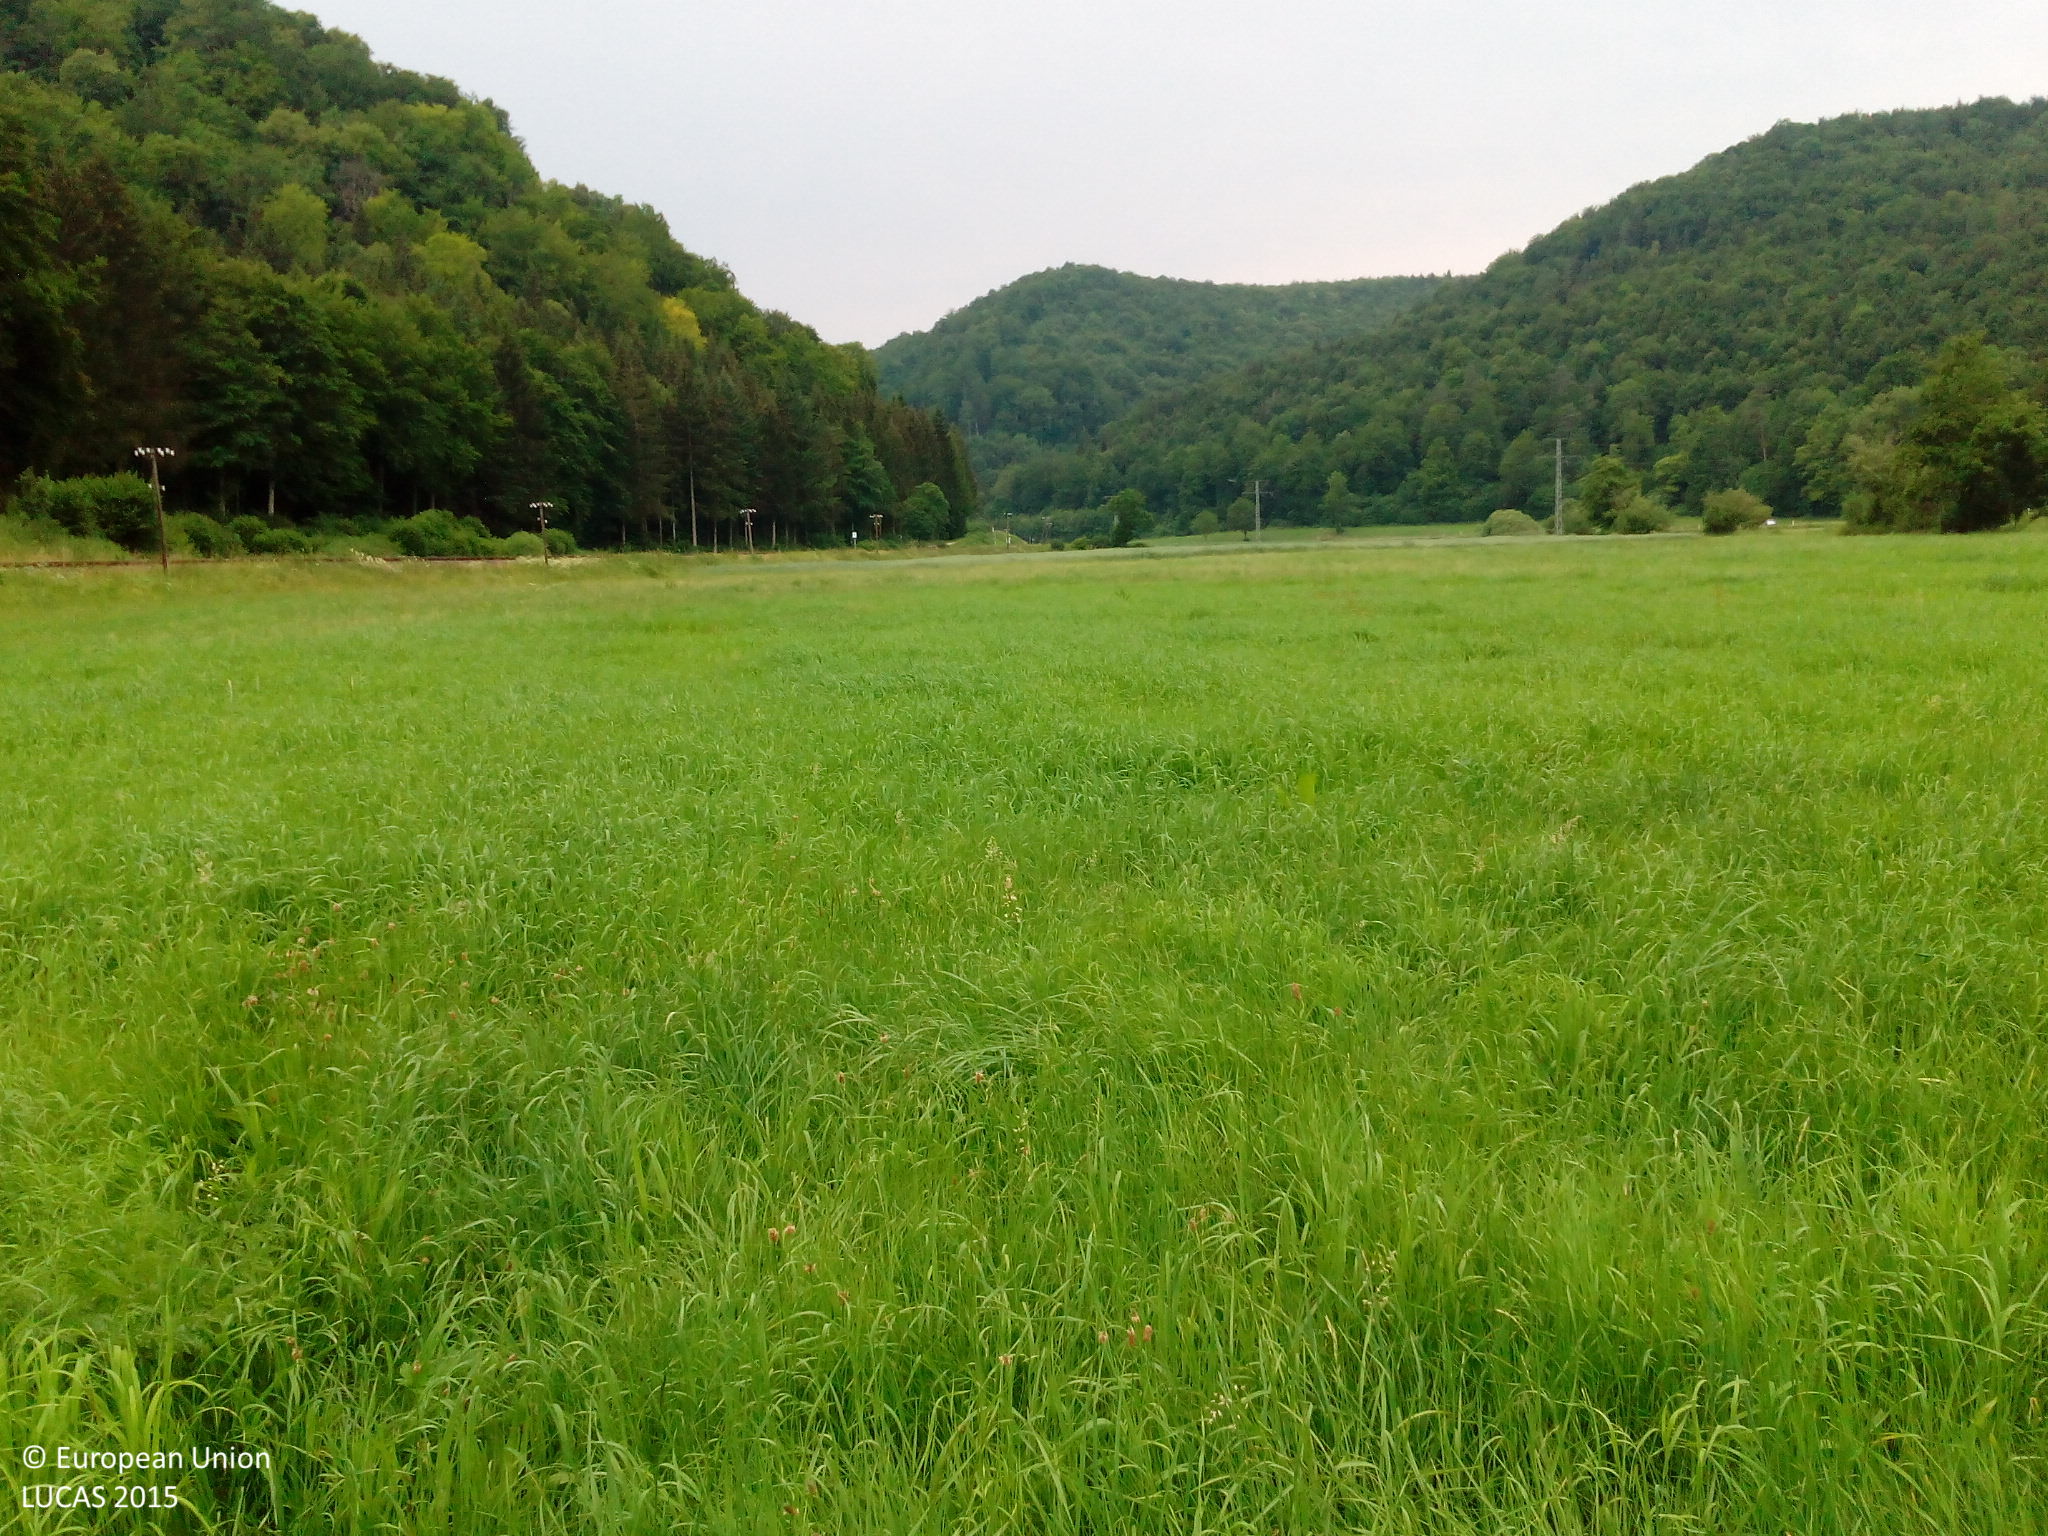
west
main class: Grassland
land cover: Grassland without tree/shrub cover
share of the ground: > 75 %
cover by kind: herbaceous plants 100 %
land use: Agriculture (excluding fallow land and kitchen gardens)
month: July
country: DE
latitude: 48.3670
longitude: 9.6897
